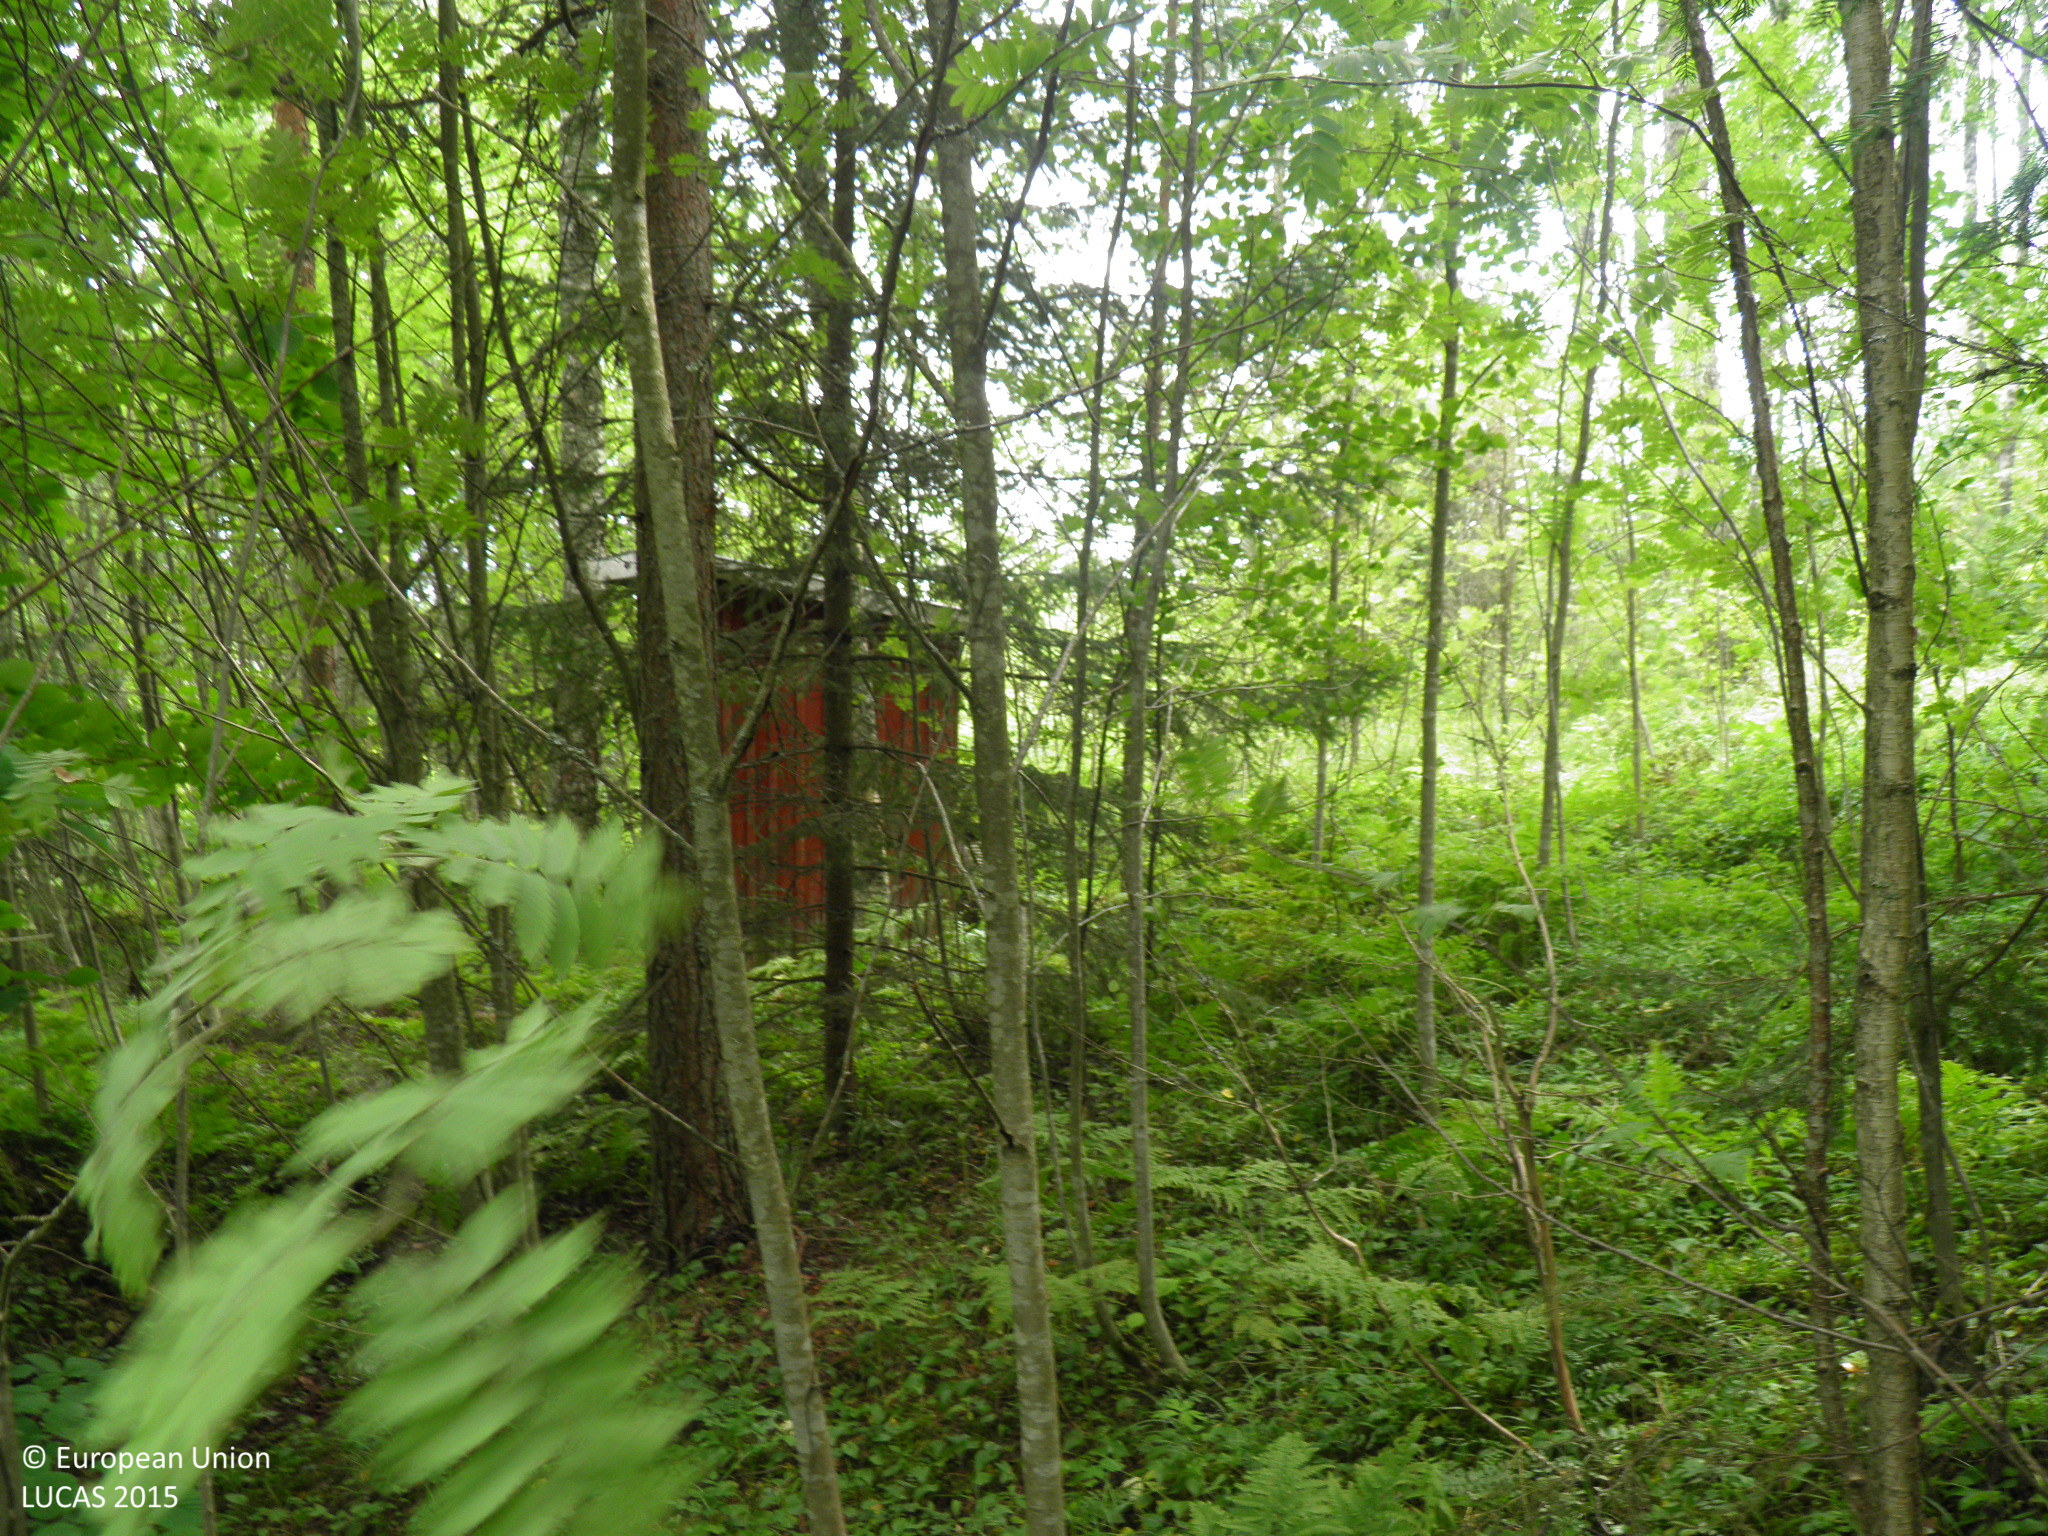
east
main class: Woodland
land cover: Pine dominated mixed woodland
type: hemiboreal forest and nemoral coniferous forest and mixed broadleaved-coniferous forest
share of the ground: > 75 %
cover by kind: broadleaved forest trees 60 %, coniferous forest trees 20 %, shrubs 10 %, herbaceous plants 10 %
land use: Residential
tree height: > 5 m
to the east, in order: Pine dominated mixed woodland; Broadleaved woodland; Paved roads, cycling and walking lanes; Ditches and canals; Grass margins; Tracks; Electric lines; Tracks; Grass margins; Barley; Electric lines; Barley; Other fresh vegetables; Electric lines; Barley; Grass margins; Ditches and canals; Broadleaved woodland; Artificial constructions in urban areas; Broadleaved woodland
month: July
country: FI
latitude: 60.0646
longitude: 22.4502
